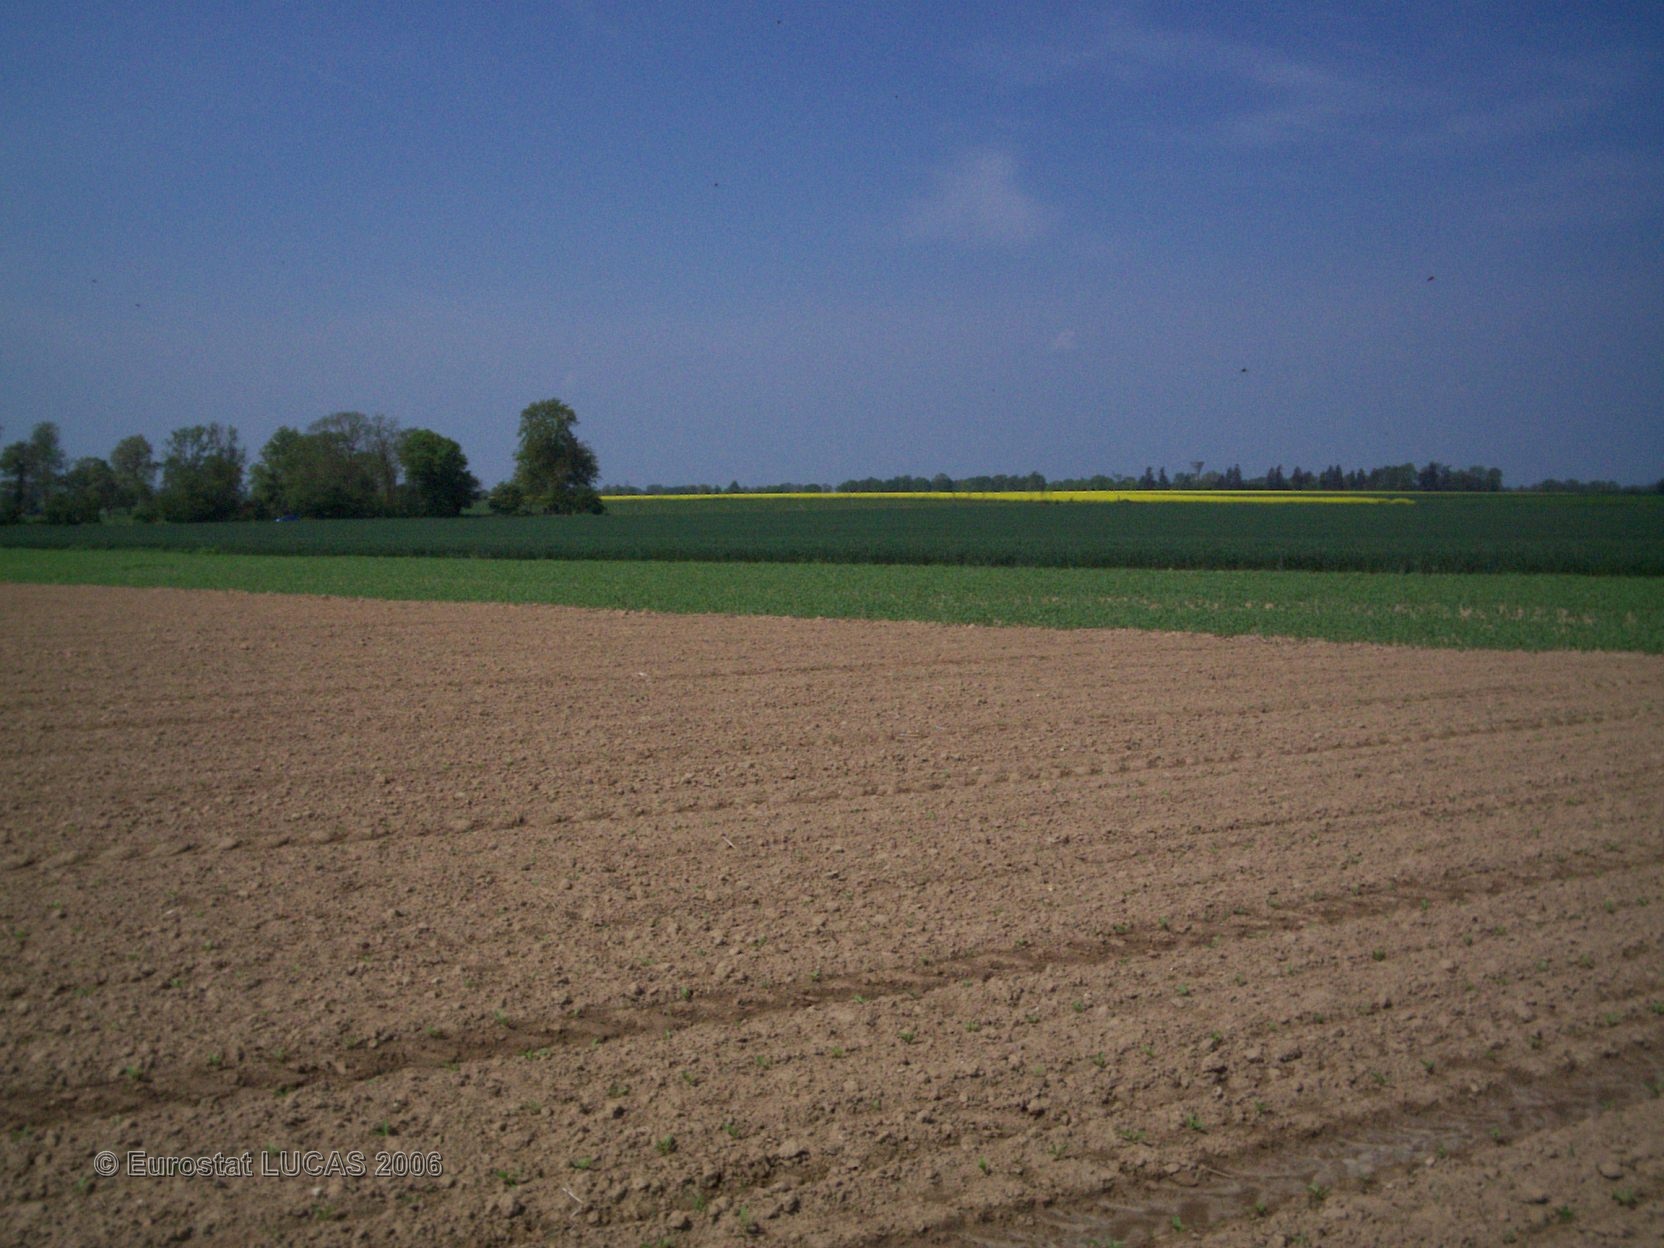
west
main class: Cropland
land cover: Sugar beet
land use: Agriculture (excluding fallow land and kitchen gardens)
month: May
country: FR
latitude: 49.1931
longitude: 0.5471
